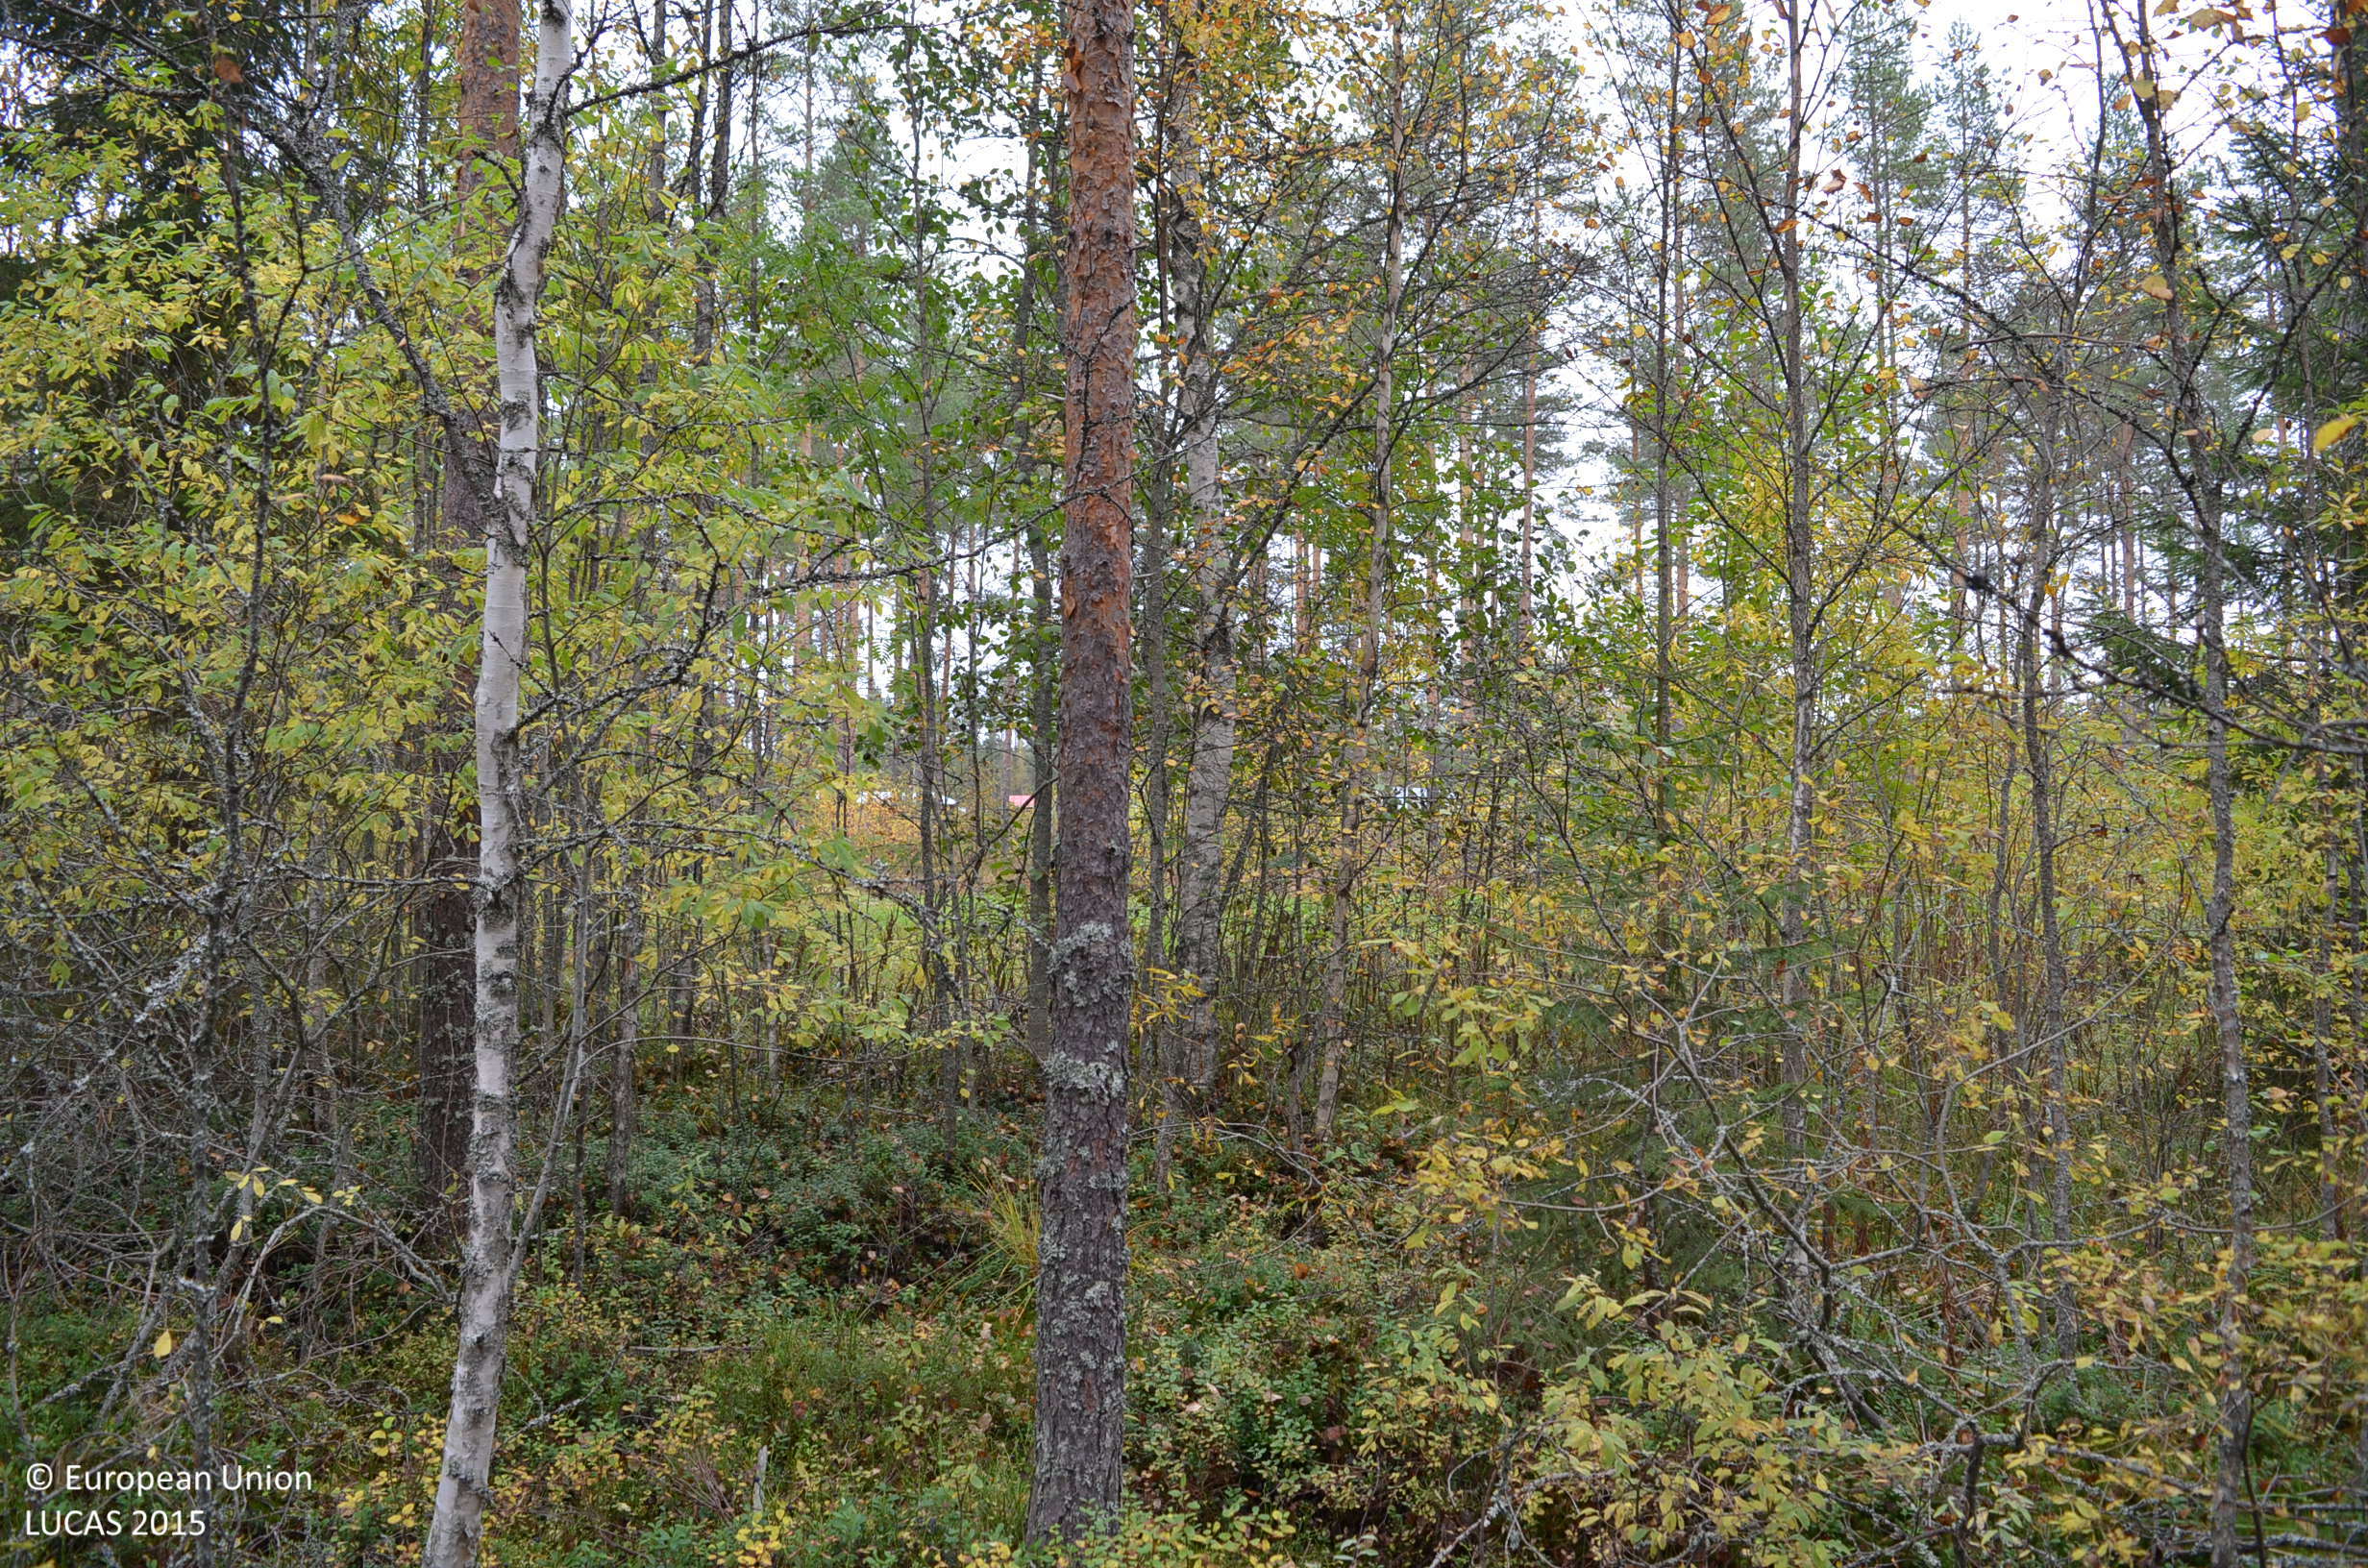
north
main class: Woodland
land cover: Pine dominated coniferous woodland
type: boreal forest
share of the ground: 50 - 75 %
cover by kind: coniferous forest trees 55 %, shrubs 25 %, broadleaved forest trees 15 %, lichens and mosses 5 %
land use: Forestry
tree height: > 5 m
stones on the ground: < 10 %
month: September
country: FI
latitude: 62.5296
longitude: 23.7355
